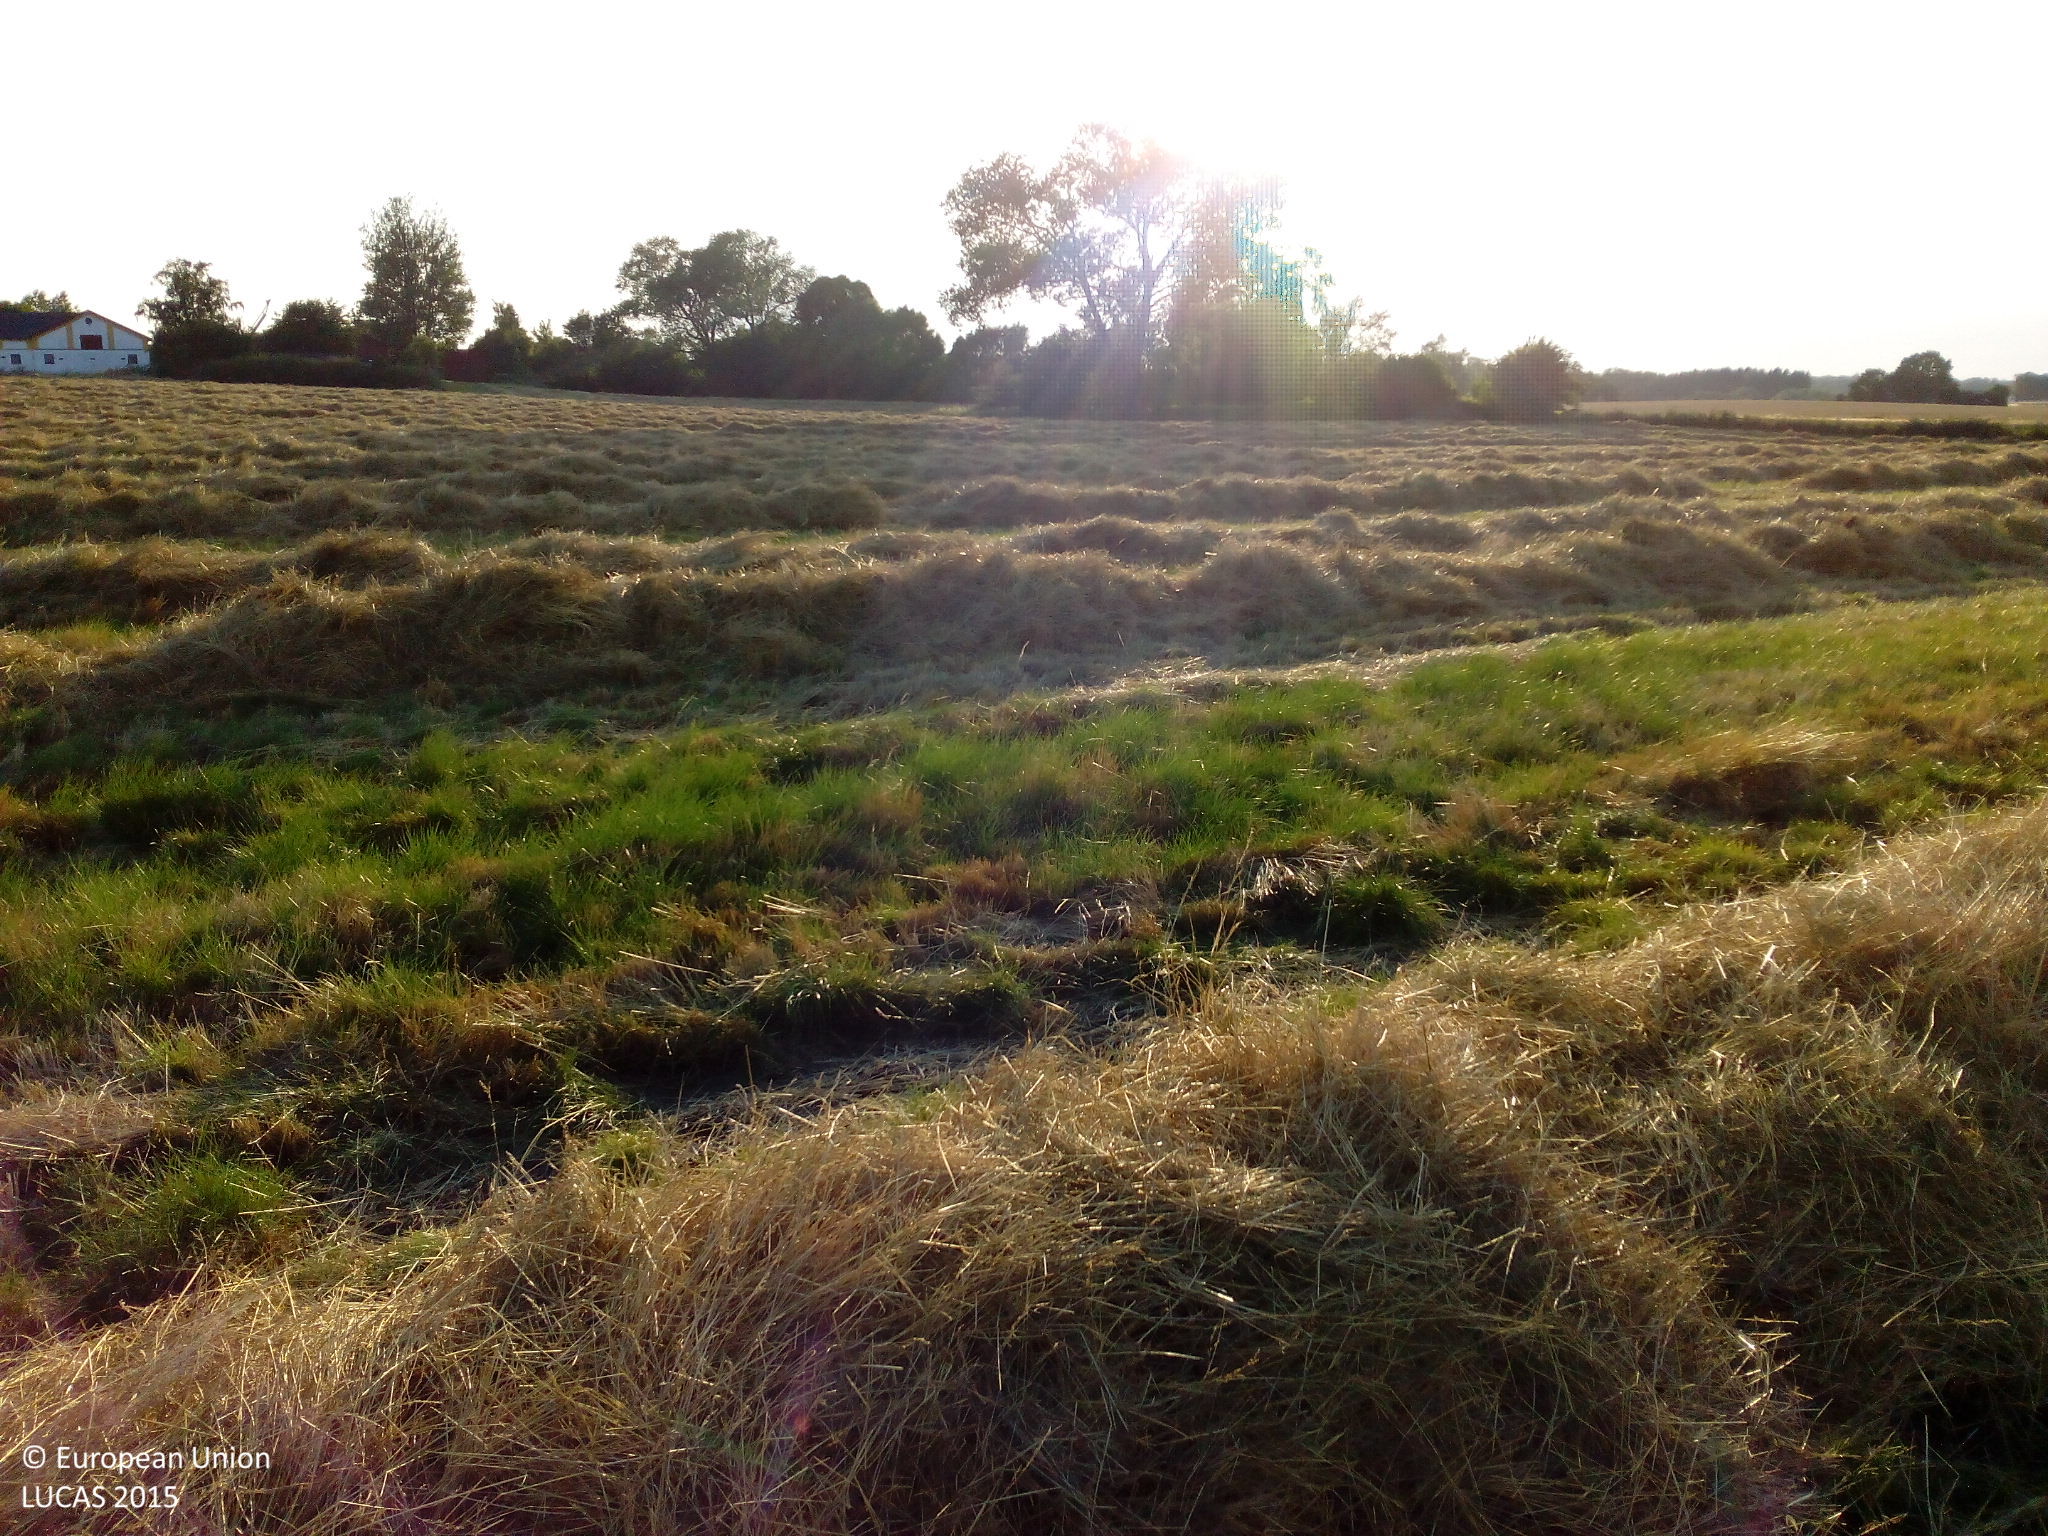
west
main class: Cropland
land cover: Temporary grasslands
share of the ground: > 75 %
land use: Agriculture (excluding fallow land and kitchen gardens)
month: August
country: DK
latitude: 55.6524
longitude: 11.8895
